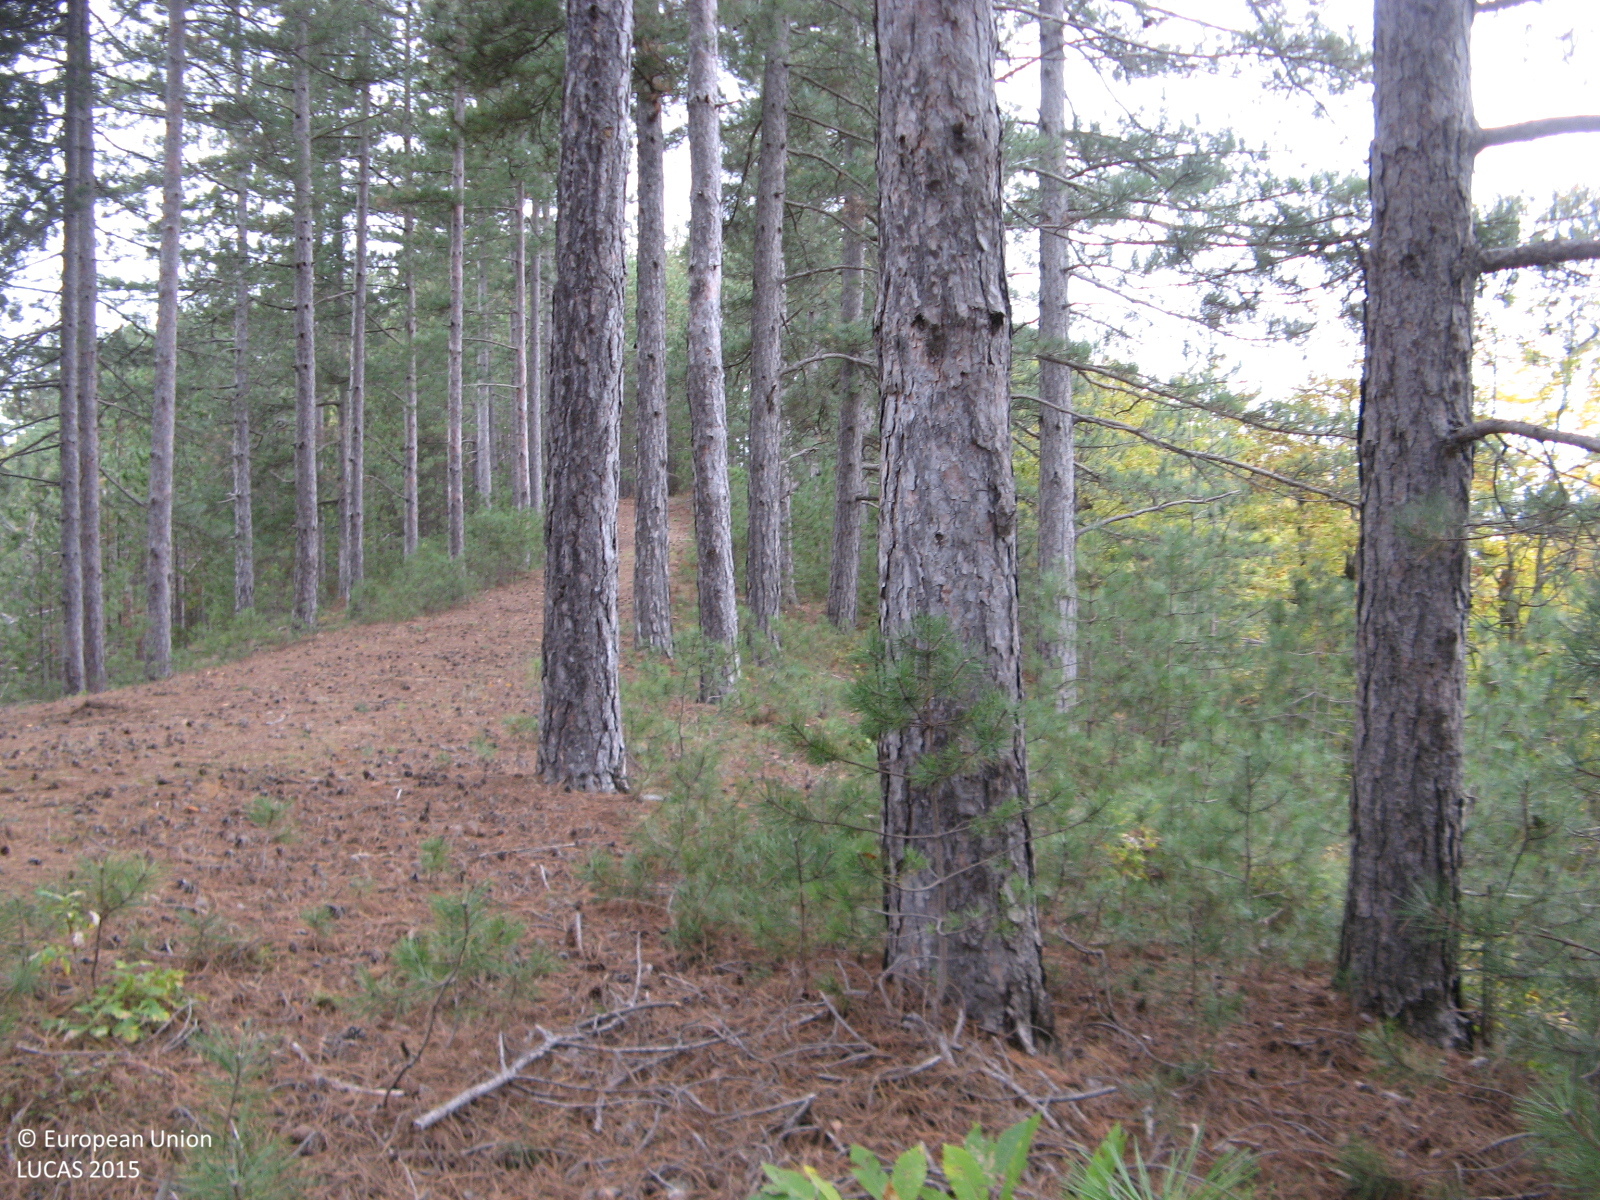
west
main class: Woodland
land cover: Pine dominated coniferous woodland
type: hemiboreal forest and nemoral coniferous forest and mixed broadleaved-coniferous forest
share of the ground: > 75 %
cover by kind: coniferous forest trees 85 %, unconsolidated bare surface 10 %, shrubs 5 %
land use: Forestry
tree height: > 5 m
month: November
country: BG
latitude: 41.4279
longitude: 25.0660
